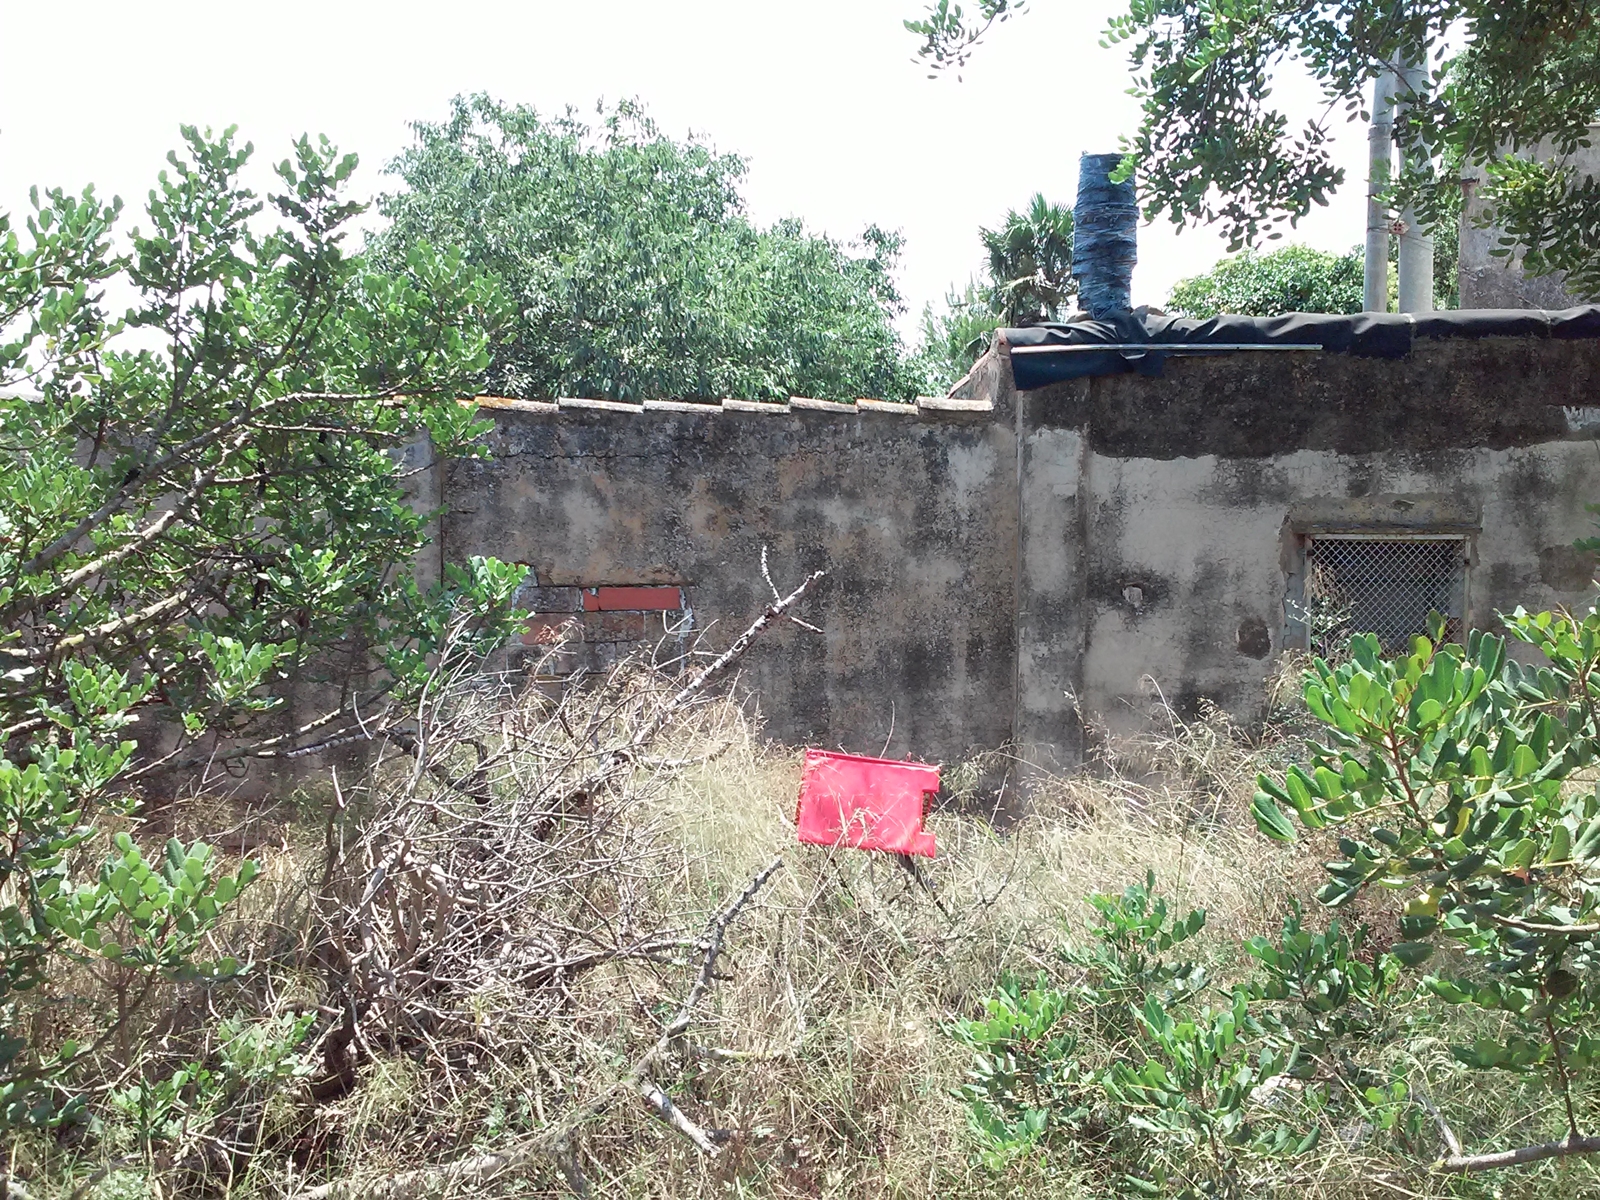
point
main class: Cropland
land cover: Permanent industrial crops
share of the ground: 25 - 50 %
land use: Abandoned areas
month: June
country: ES
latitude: 41.2951
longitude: 1.2631
